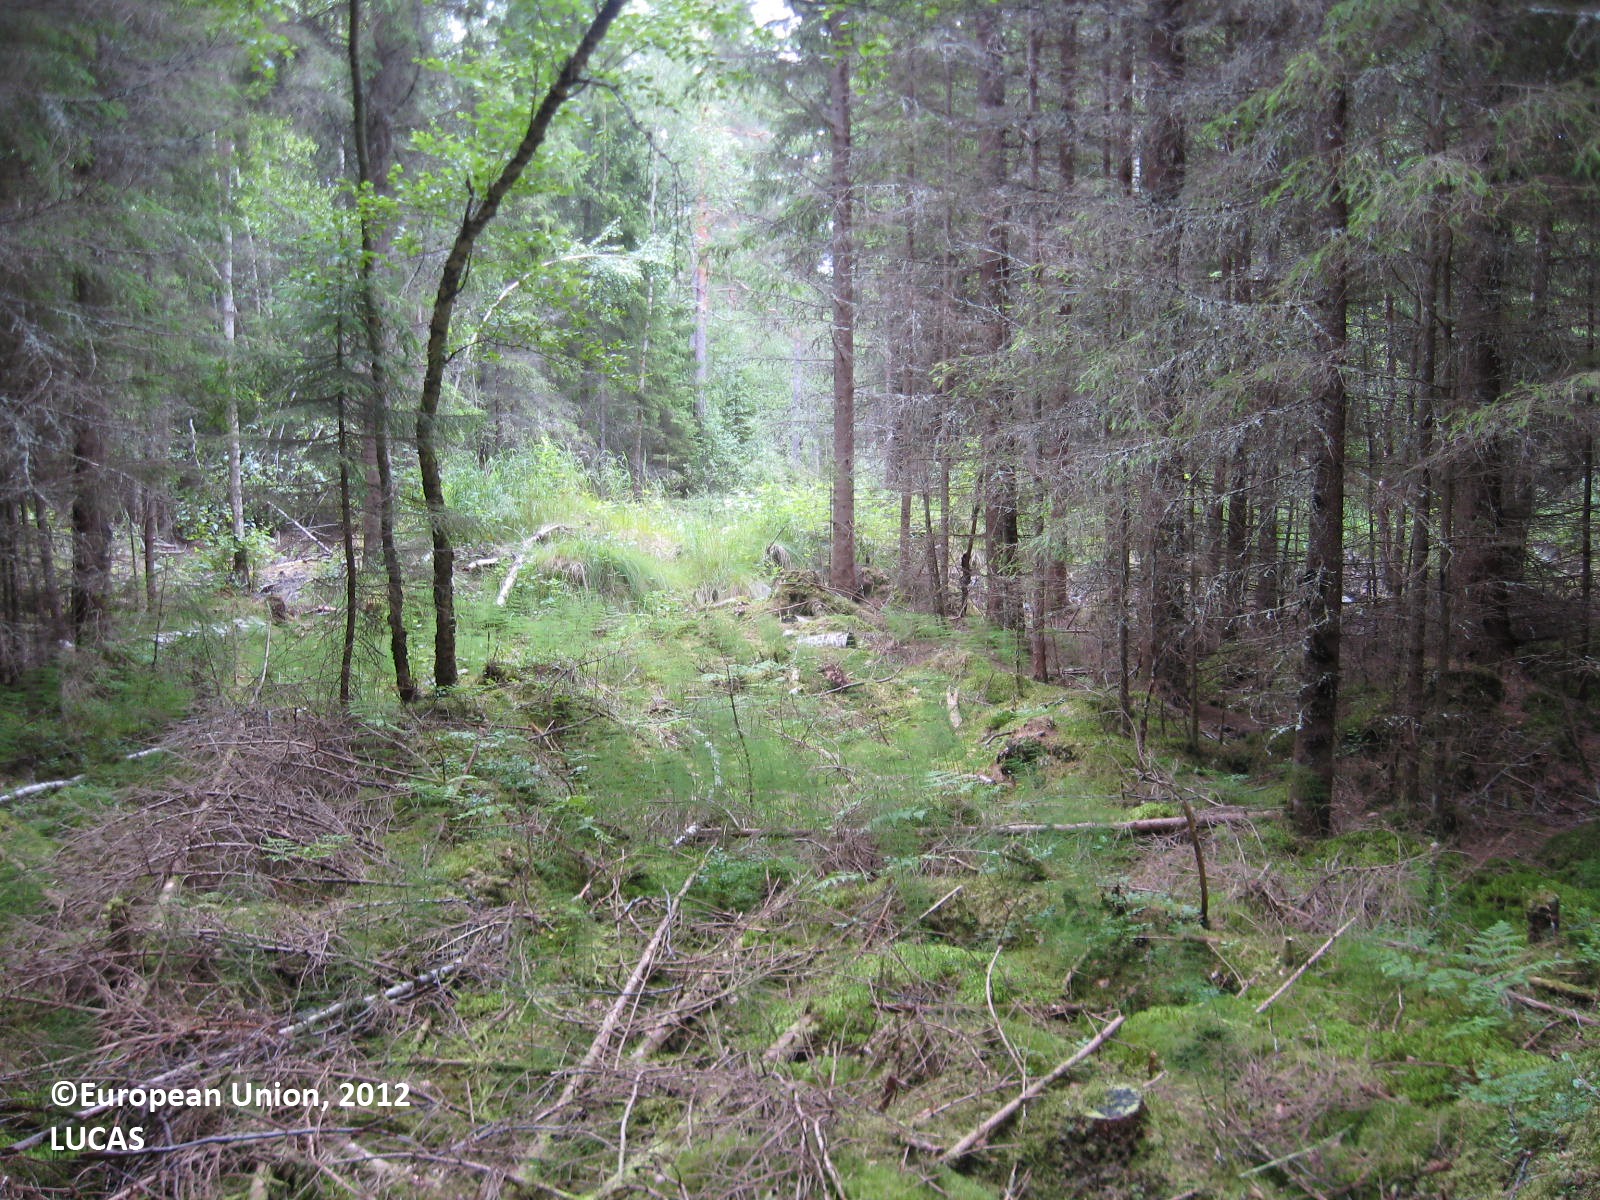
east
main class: Woodland
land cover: Spruce dominated mixed woodland
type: boreal forest
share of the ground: > 75 %
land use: Forestry
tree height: > 5 m
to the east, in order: Spruce dominated mixed woodland; Ditches and canals; Pine dominated mixed woodland; Shruby margins; Ditches and canals; Shruby margins; Spruce dominated coniferous woodland
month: July
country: FI
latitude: 62.0719
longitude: 21.3560
